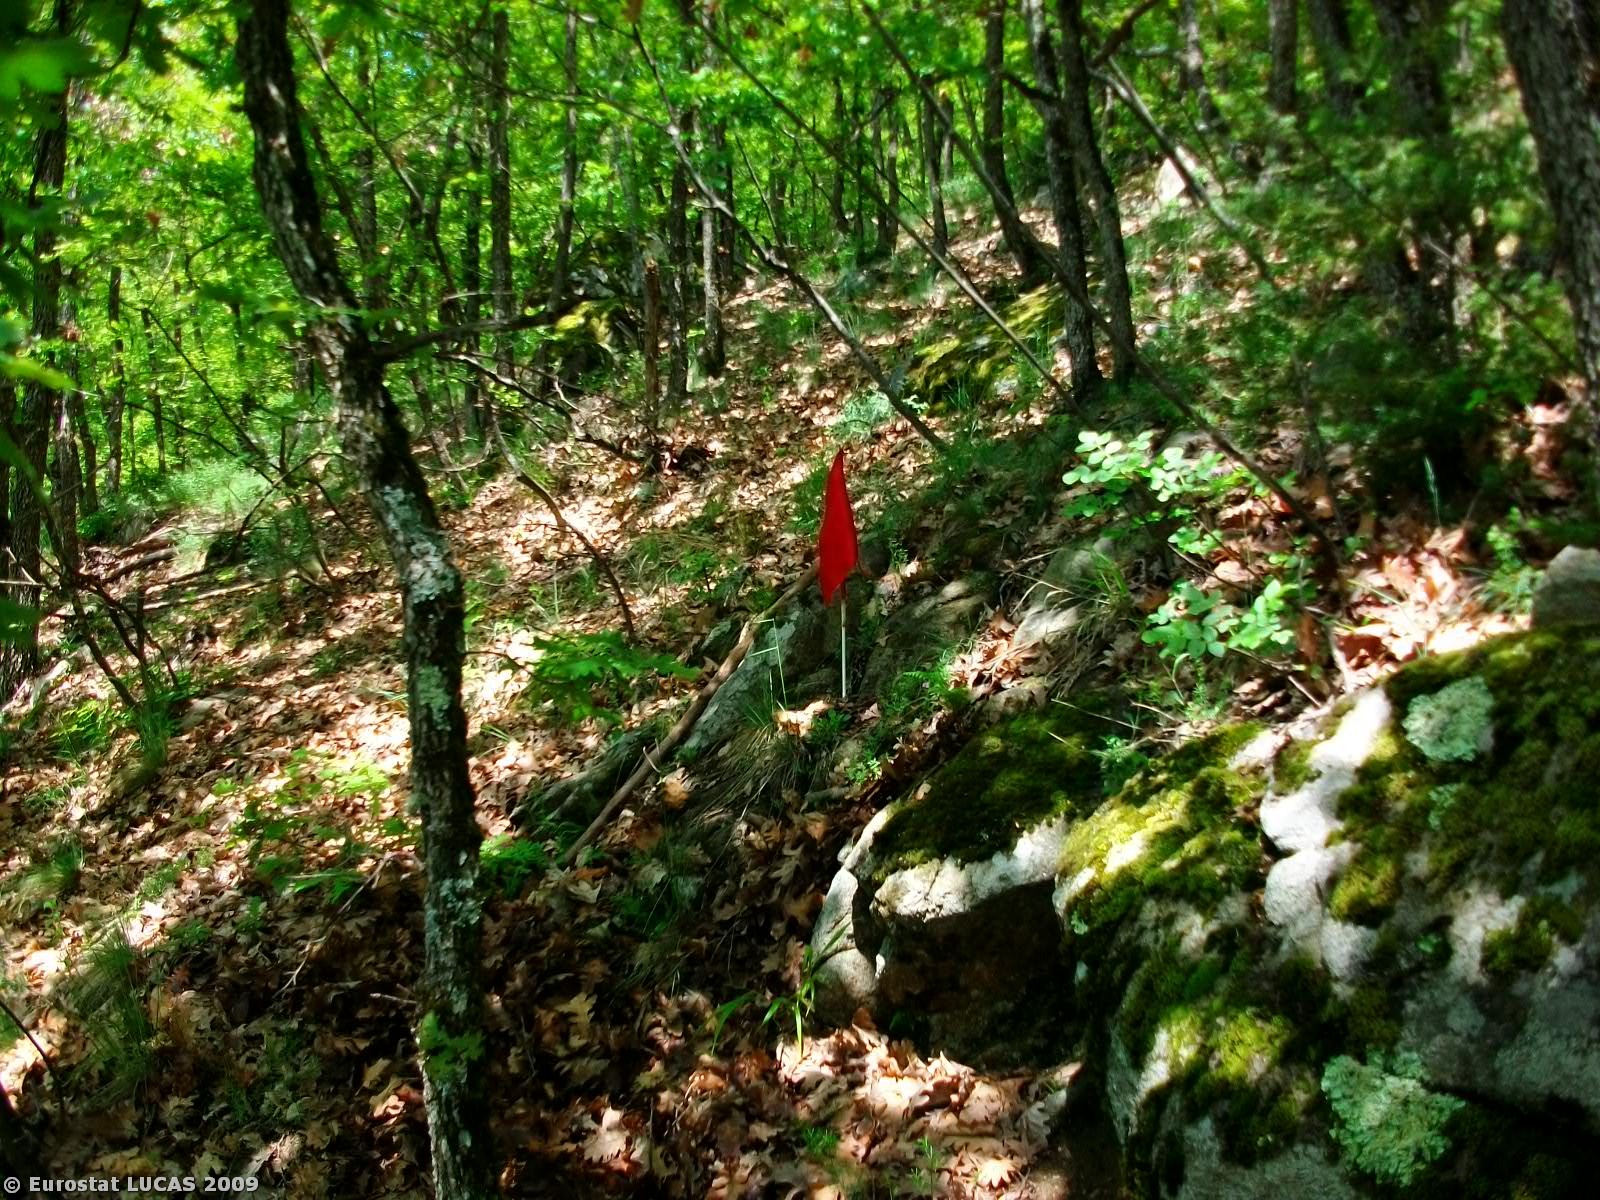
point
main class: Woodland
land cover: Broadleaved woodland
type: mesophytic deciduous forest
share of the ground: > 75 %
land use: Forestry
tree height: > 5 m
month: May
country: GR
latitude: 41.2723
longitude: 24.6388
